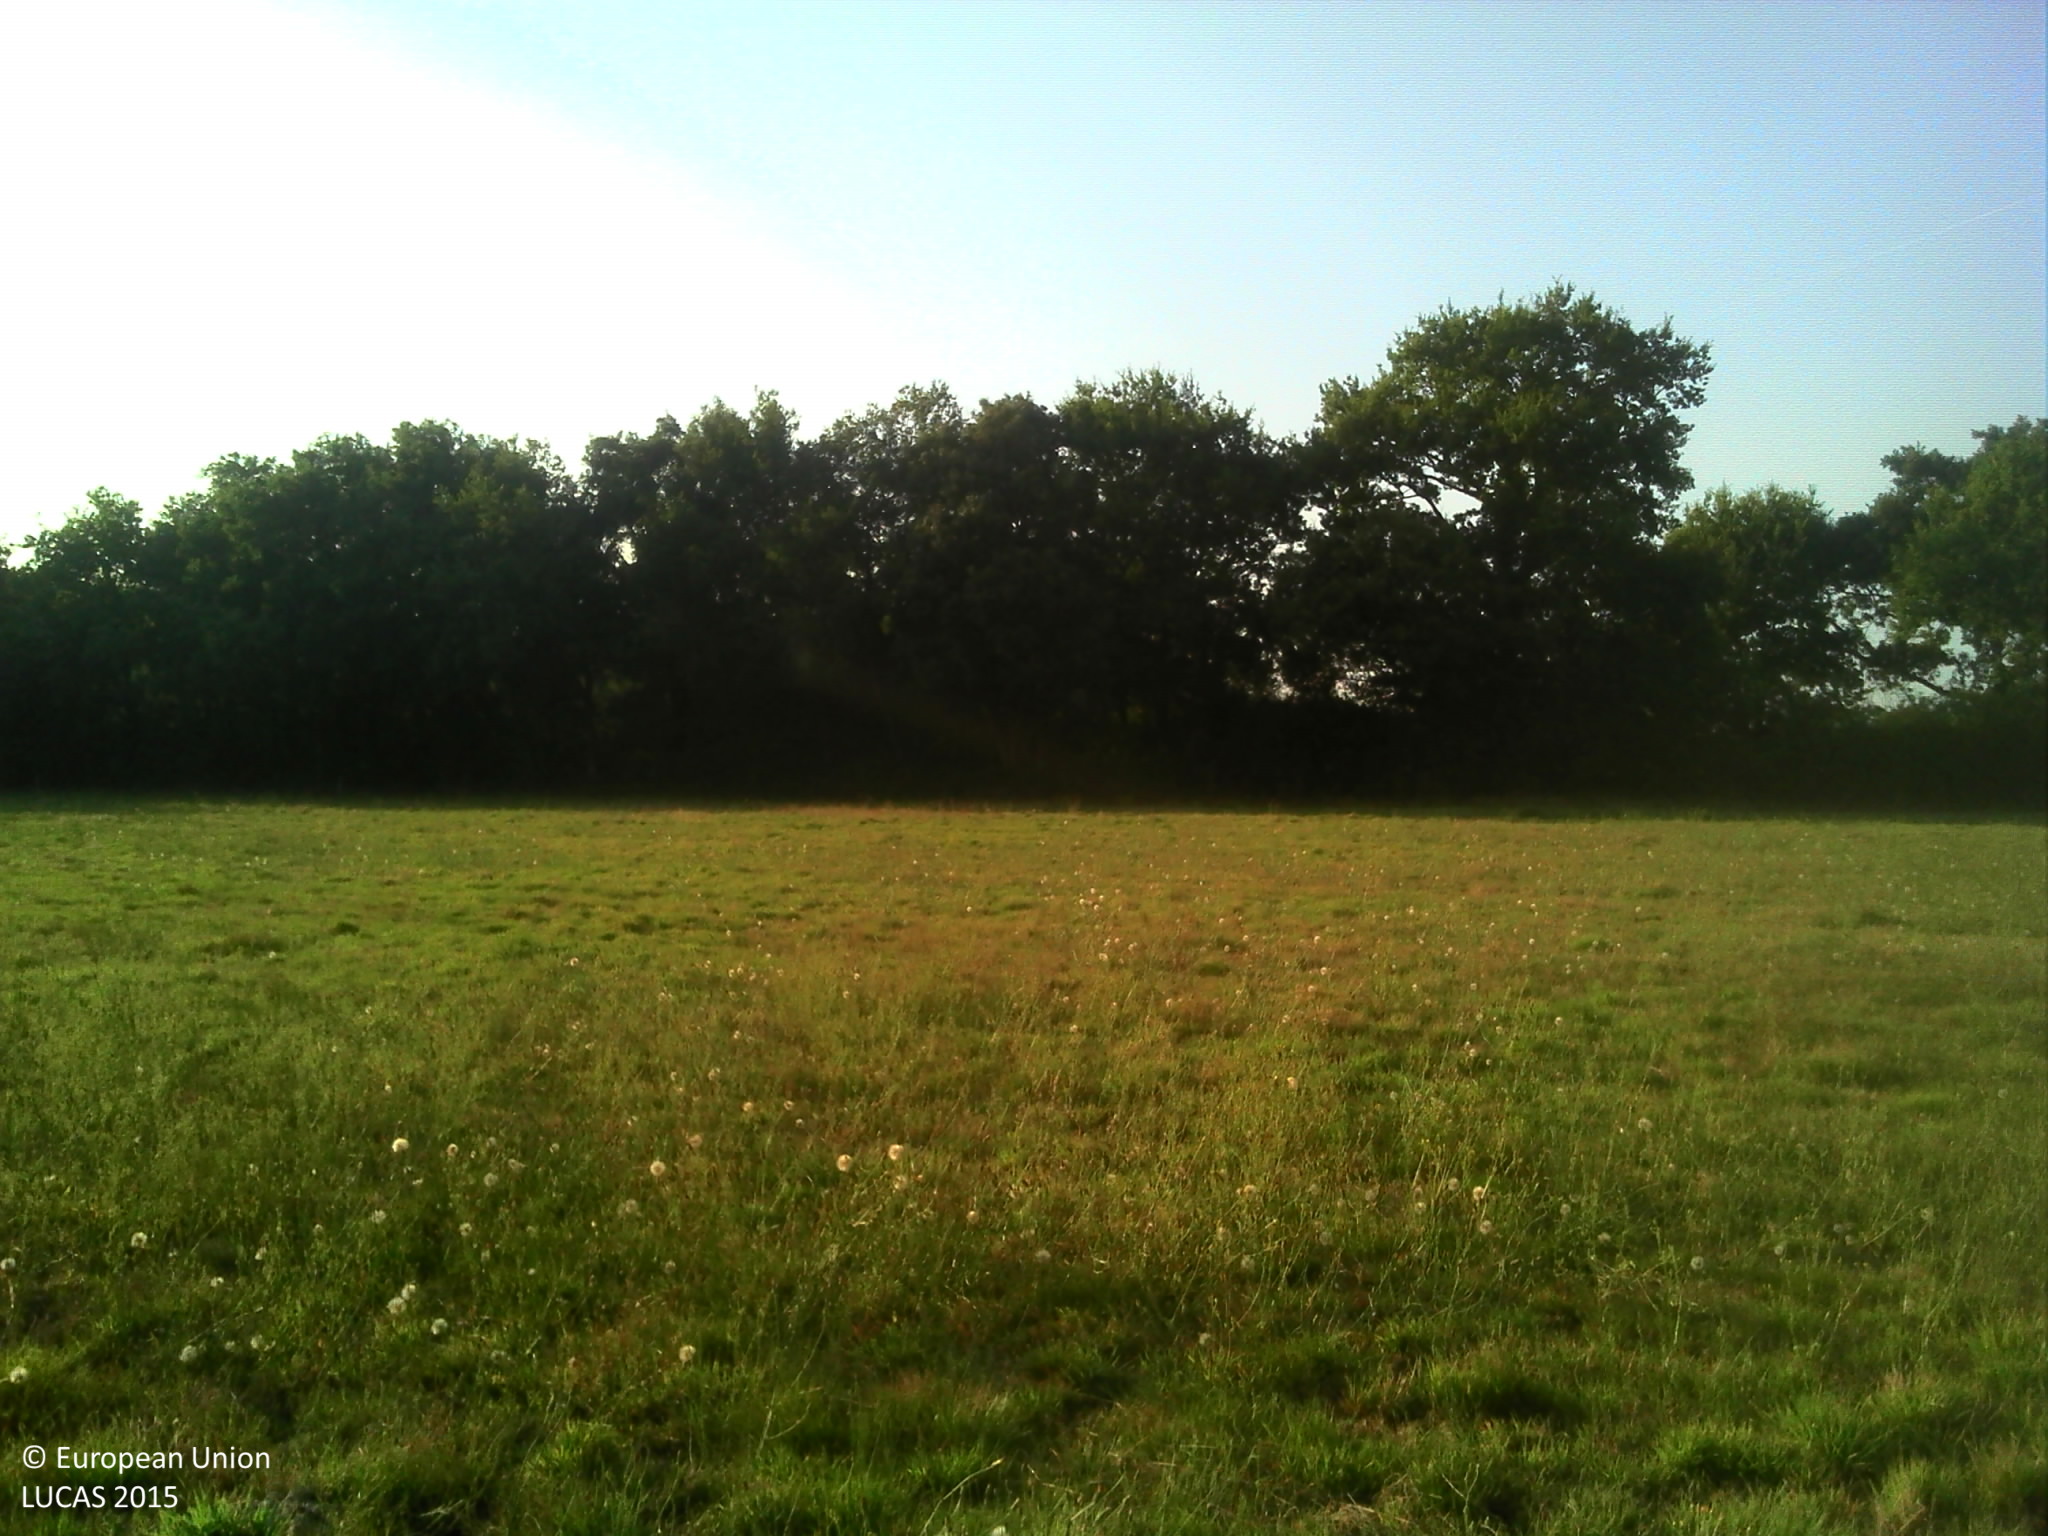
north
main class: Grassland
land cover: Grassland without tree/shrub cover
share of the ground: > 75 %
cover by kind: herbaceous plants 100 %
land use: Agriculture (excluding fallow land and kitchen gardens)
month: July
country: FR
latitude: 46.4917
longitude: -1.6742
